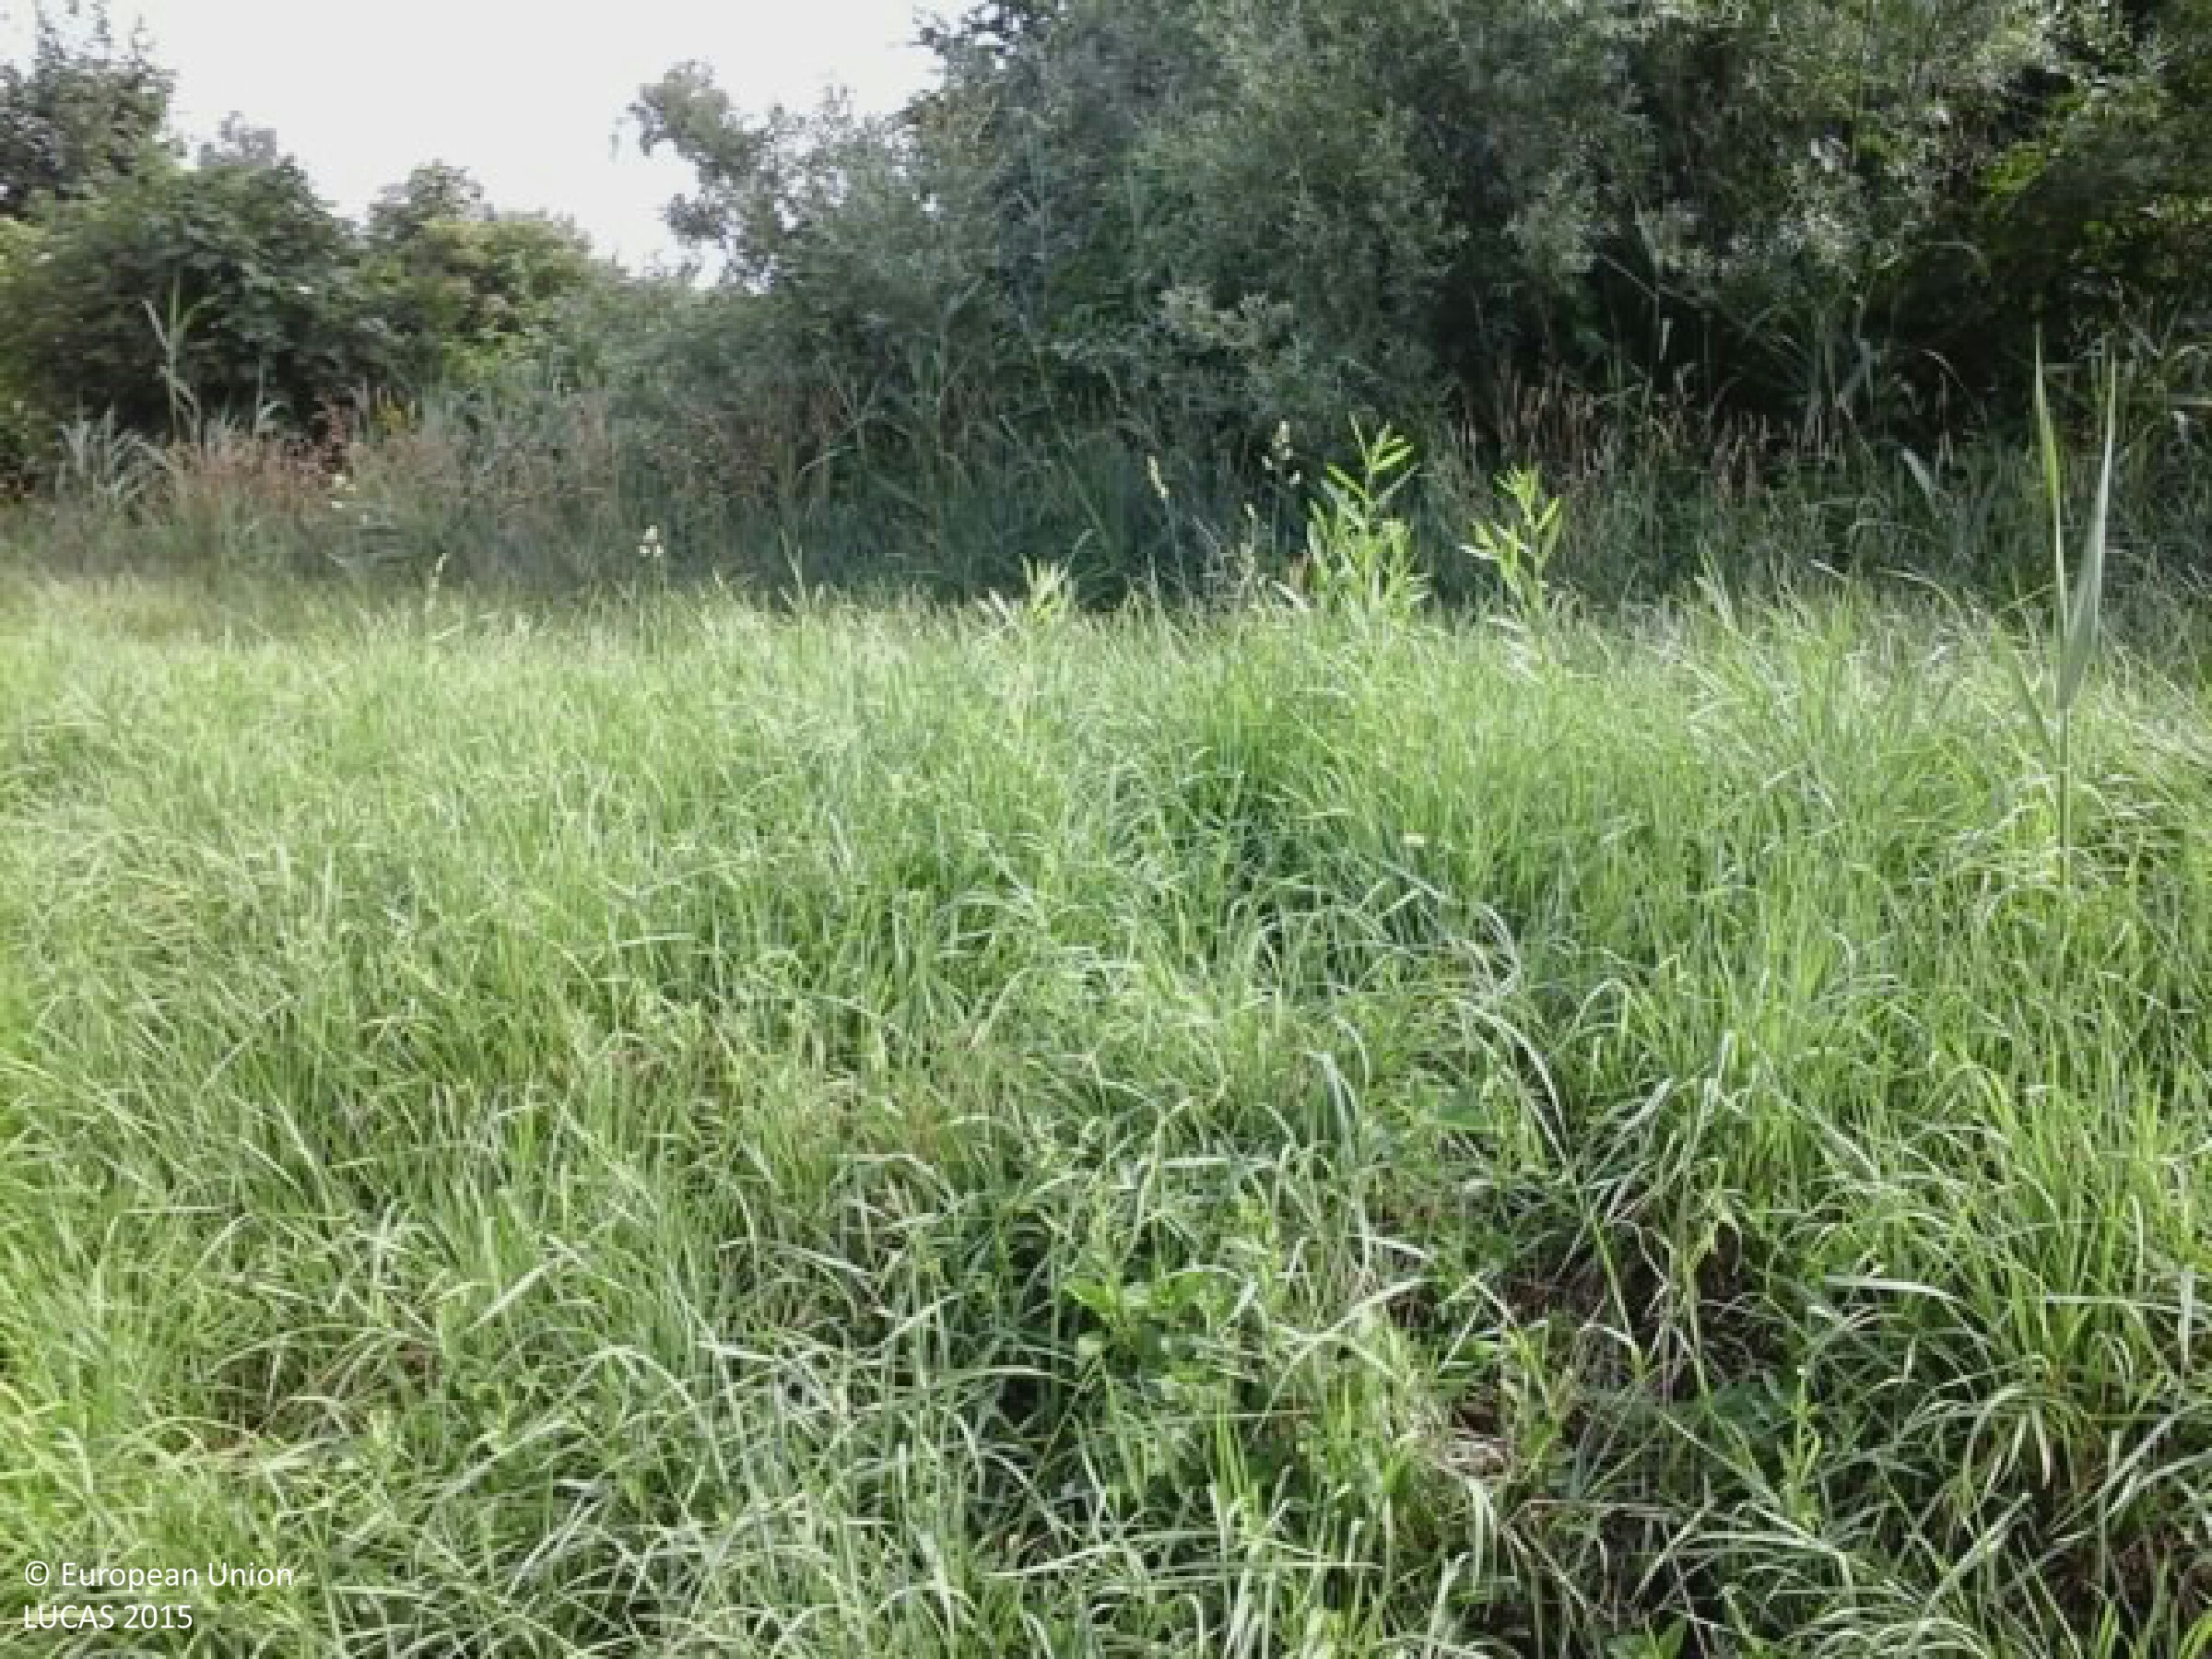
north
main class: Grassland
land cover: Grassland without tree/shrub cover
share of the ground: > 75 %
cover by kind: herbaceous plants 100 %
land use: Semi-natural and natural areas not in use
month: June
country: HU
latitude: 47.5528
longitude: 19.1480
